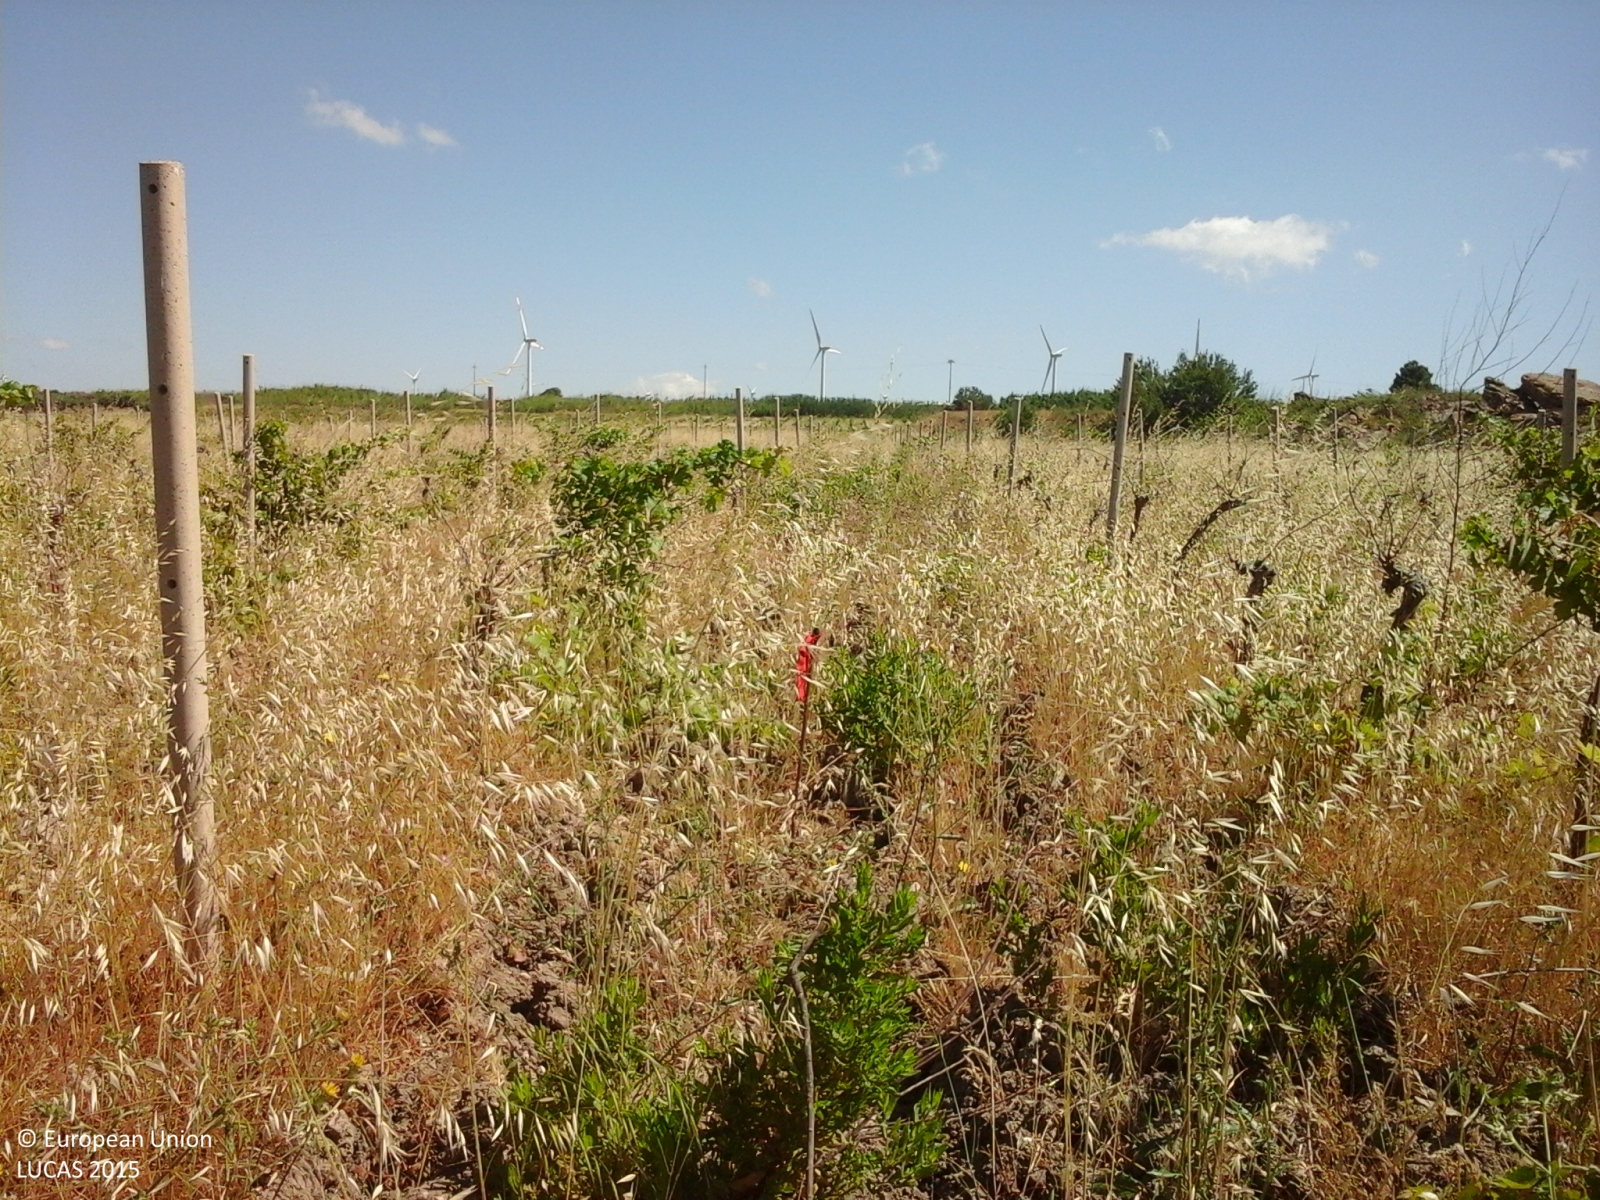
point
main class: Cropland
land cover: Vineyards
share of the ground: < 10 %
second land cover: Spontaneously vegetated surfaces
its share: > 75 %
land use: Abandoned areas
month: June
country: IT
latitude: 37.7089
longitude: 12.7133
